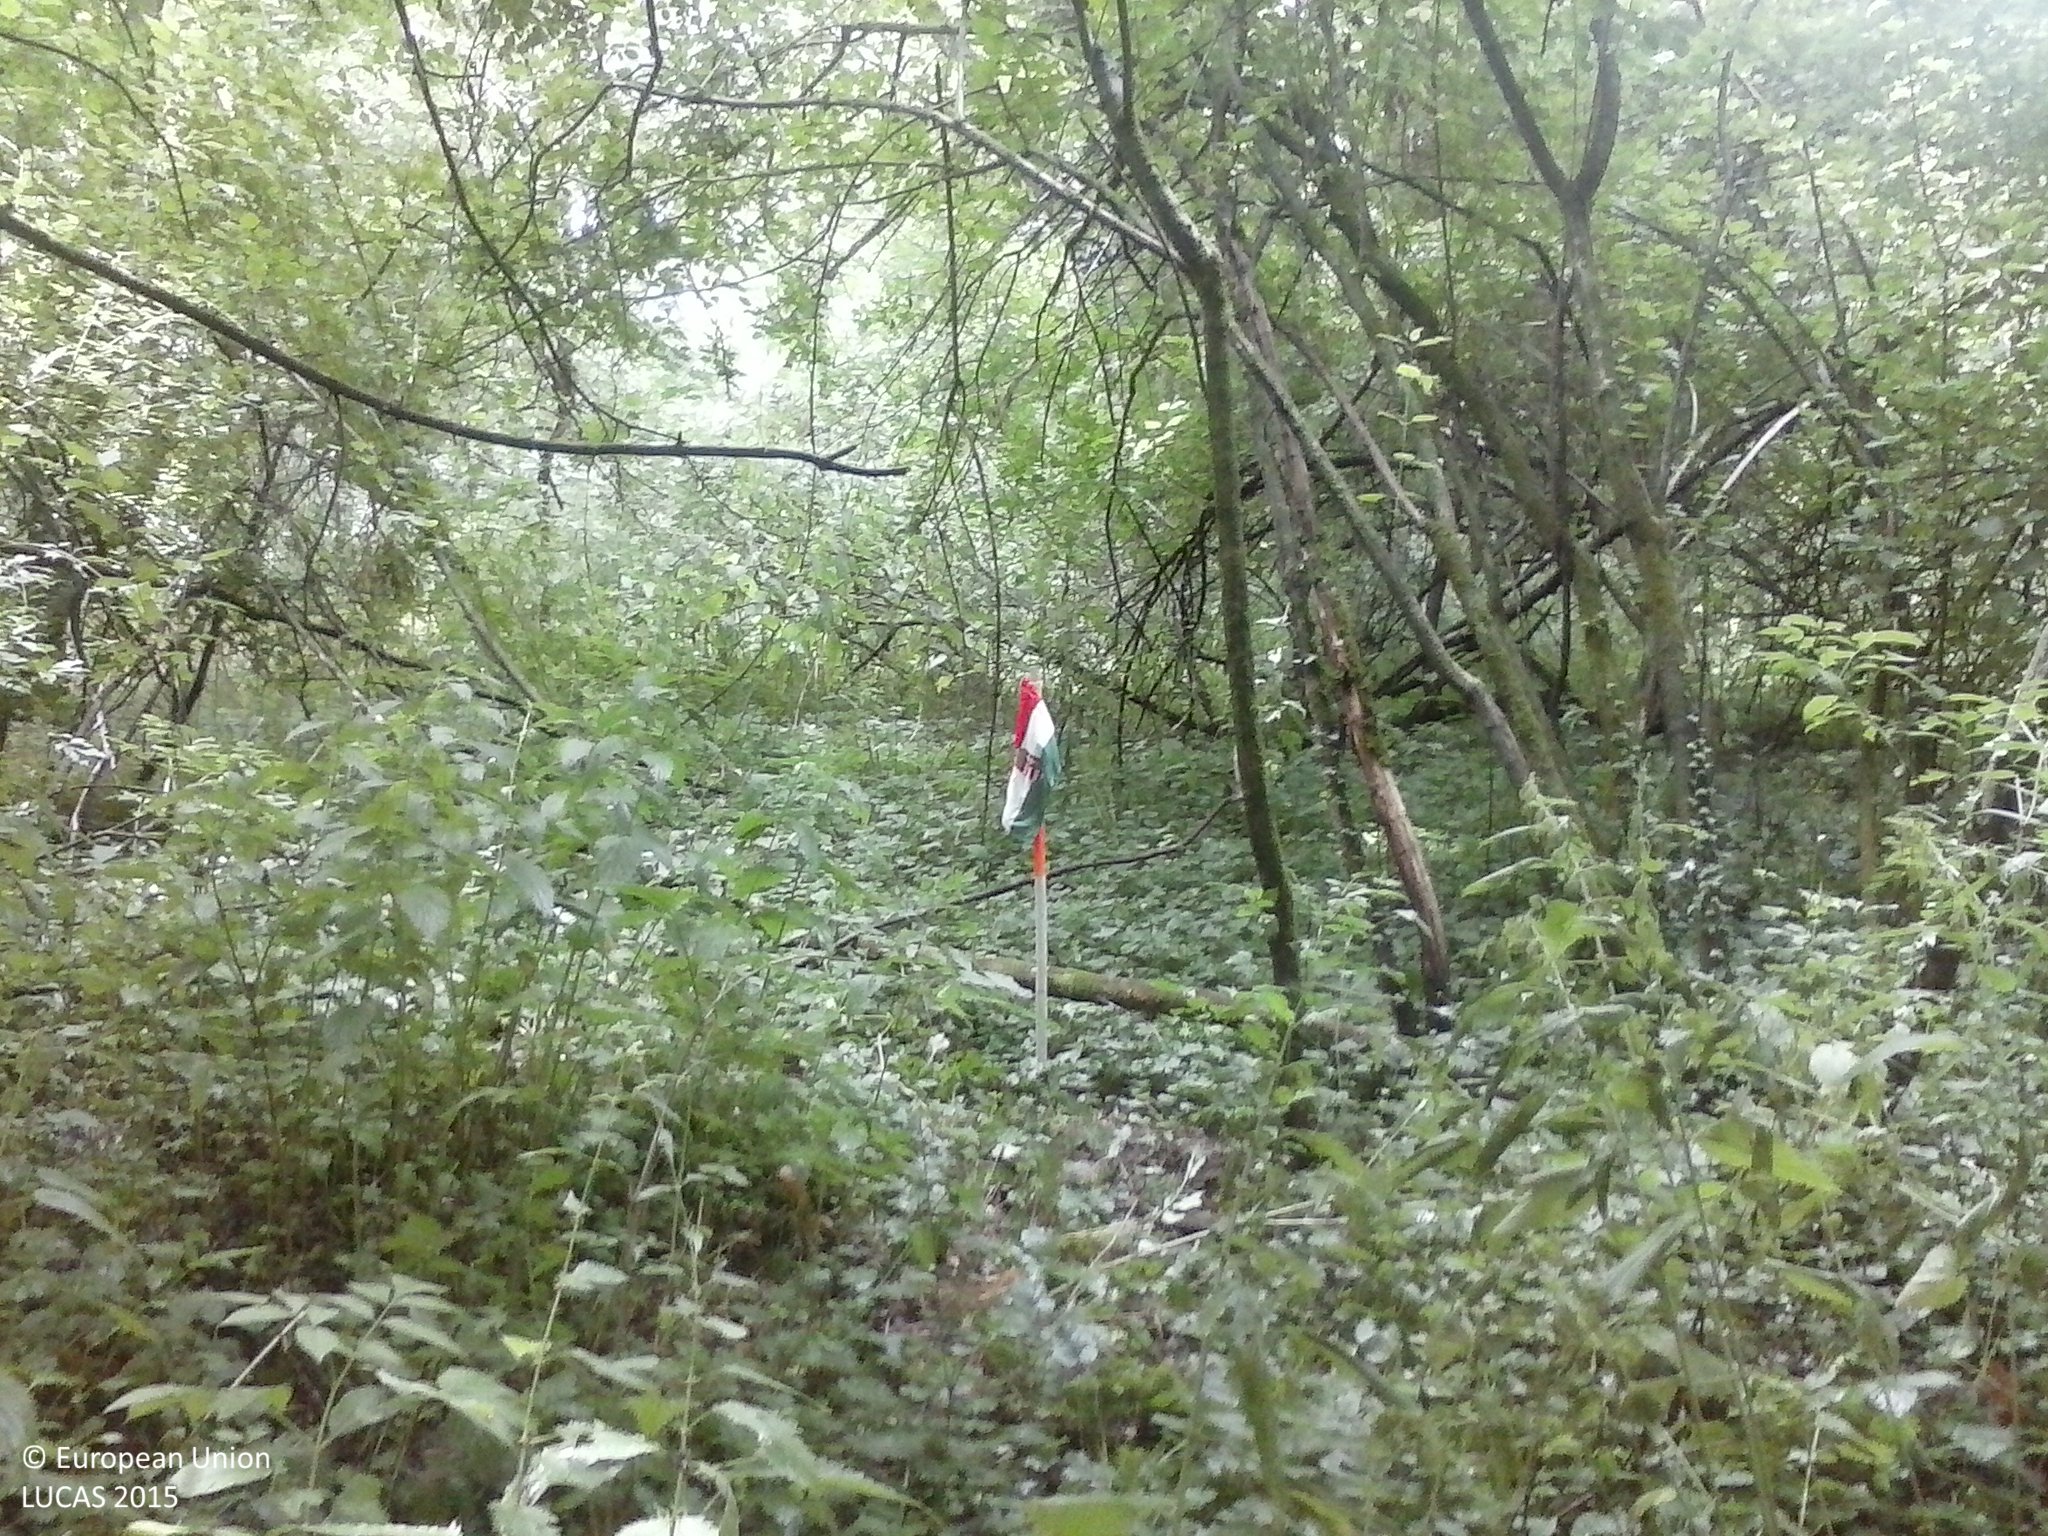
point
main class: Woodland
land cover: Broadleaved woodland
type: mesophytic deciduous forest
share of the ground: > 75 %
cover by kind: broadleaved forest trees 90 %, shrubs 5 %, herbaceous plants 5 %
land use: Forestry
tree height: > 5 m
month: July
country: HU
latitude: 46.0130
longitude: 17.2738
